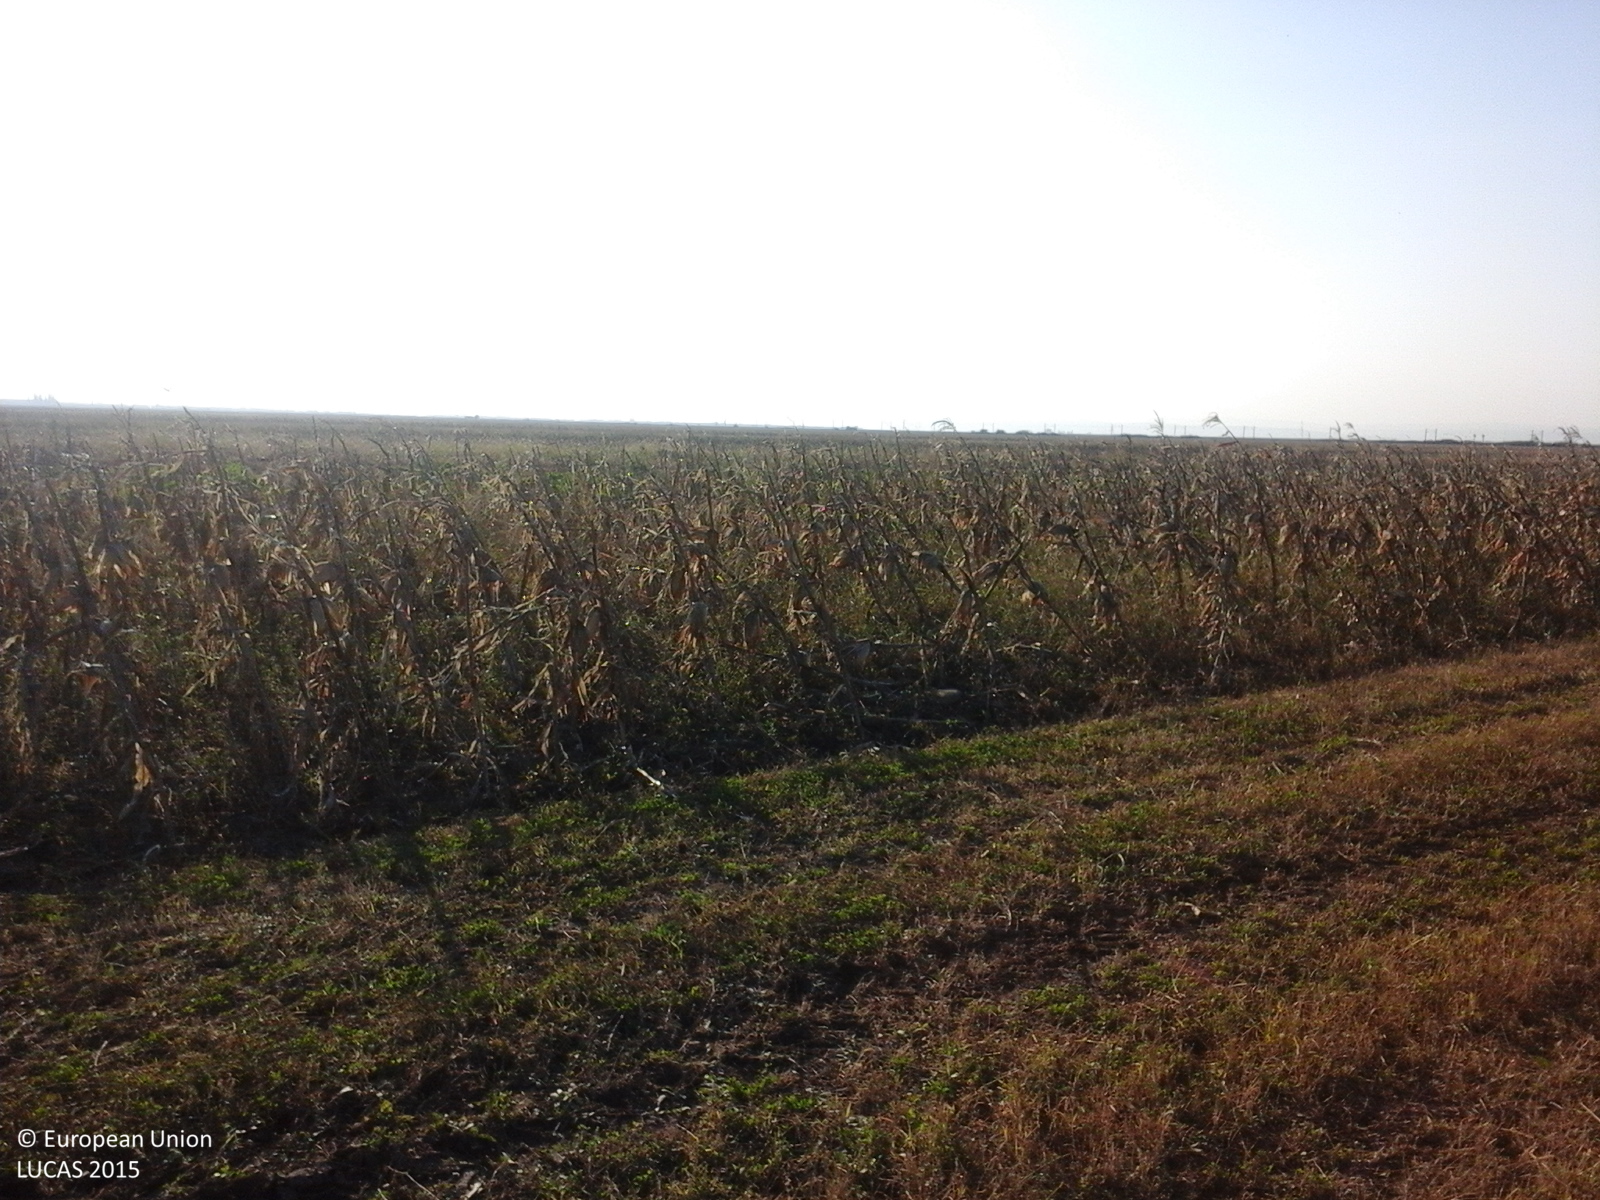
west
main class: Cropland
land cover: Lucerne
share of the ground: > 75 %
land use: Agriculture (excluding fallow land and kitchen gardens)
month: October
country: RO
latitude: 45.1924
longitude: 26.9229
